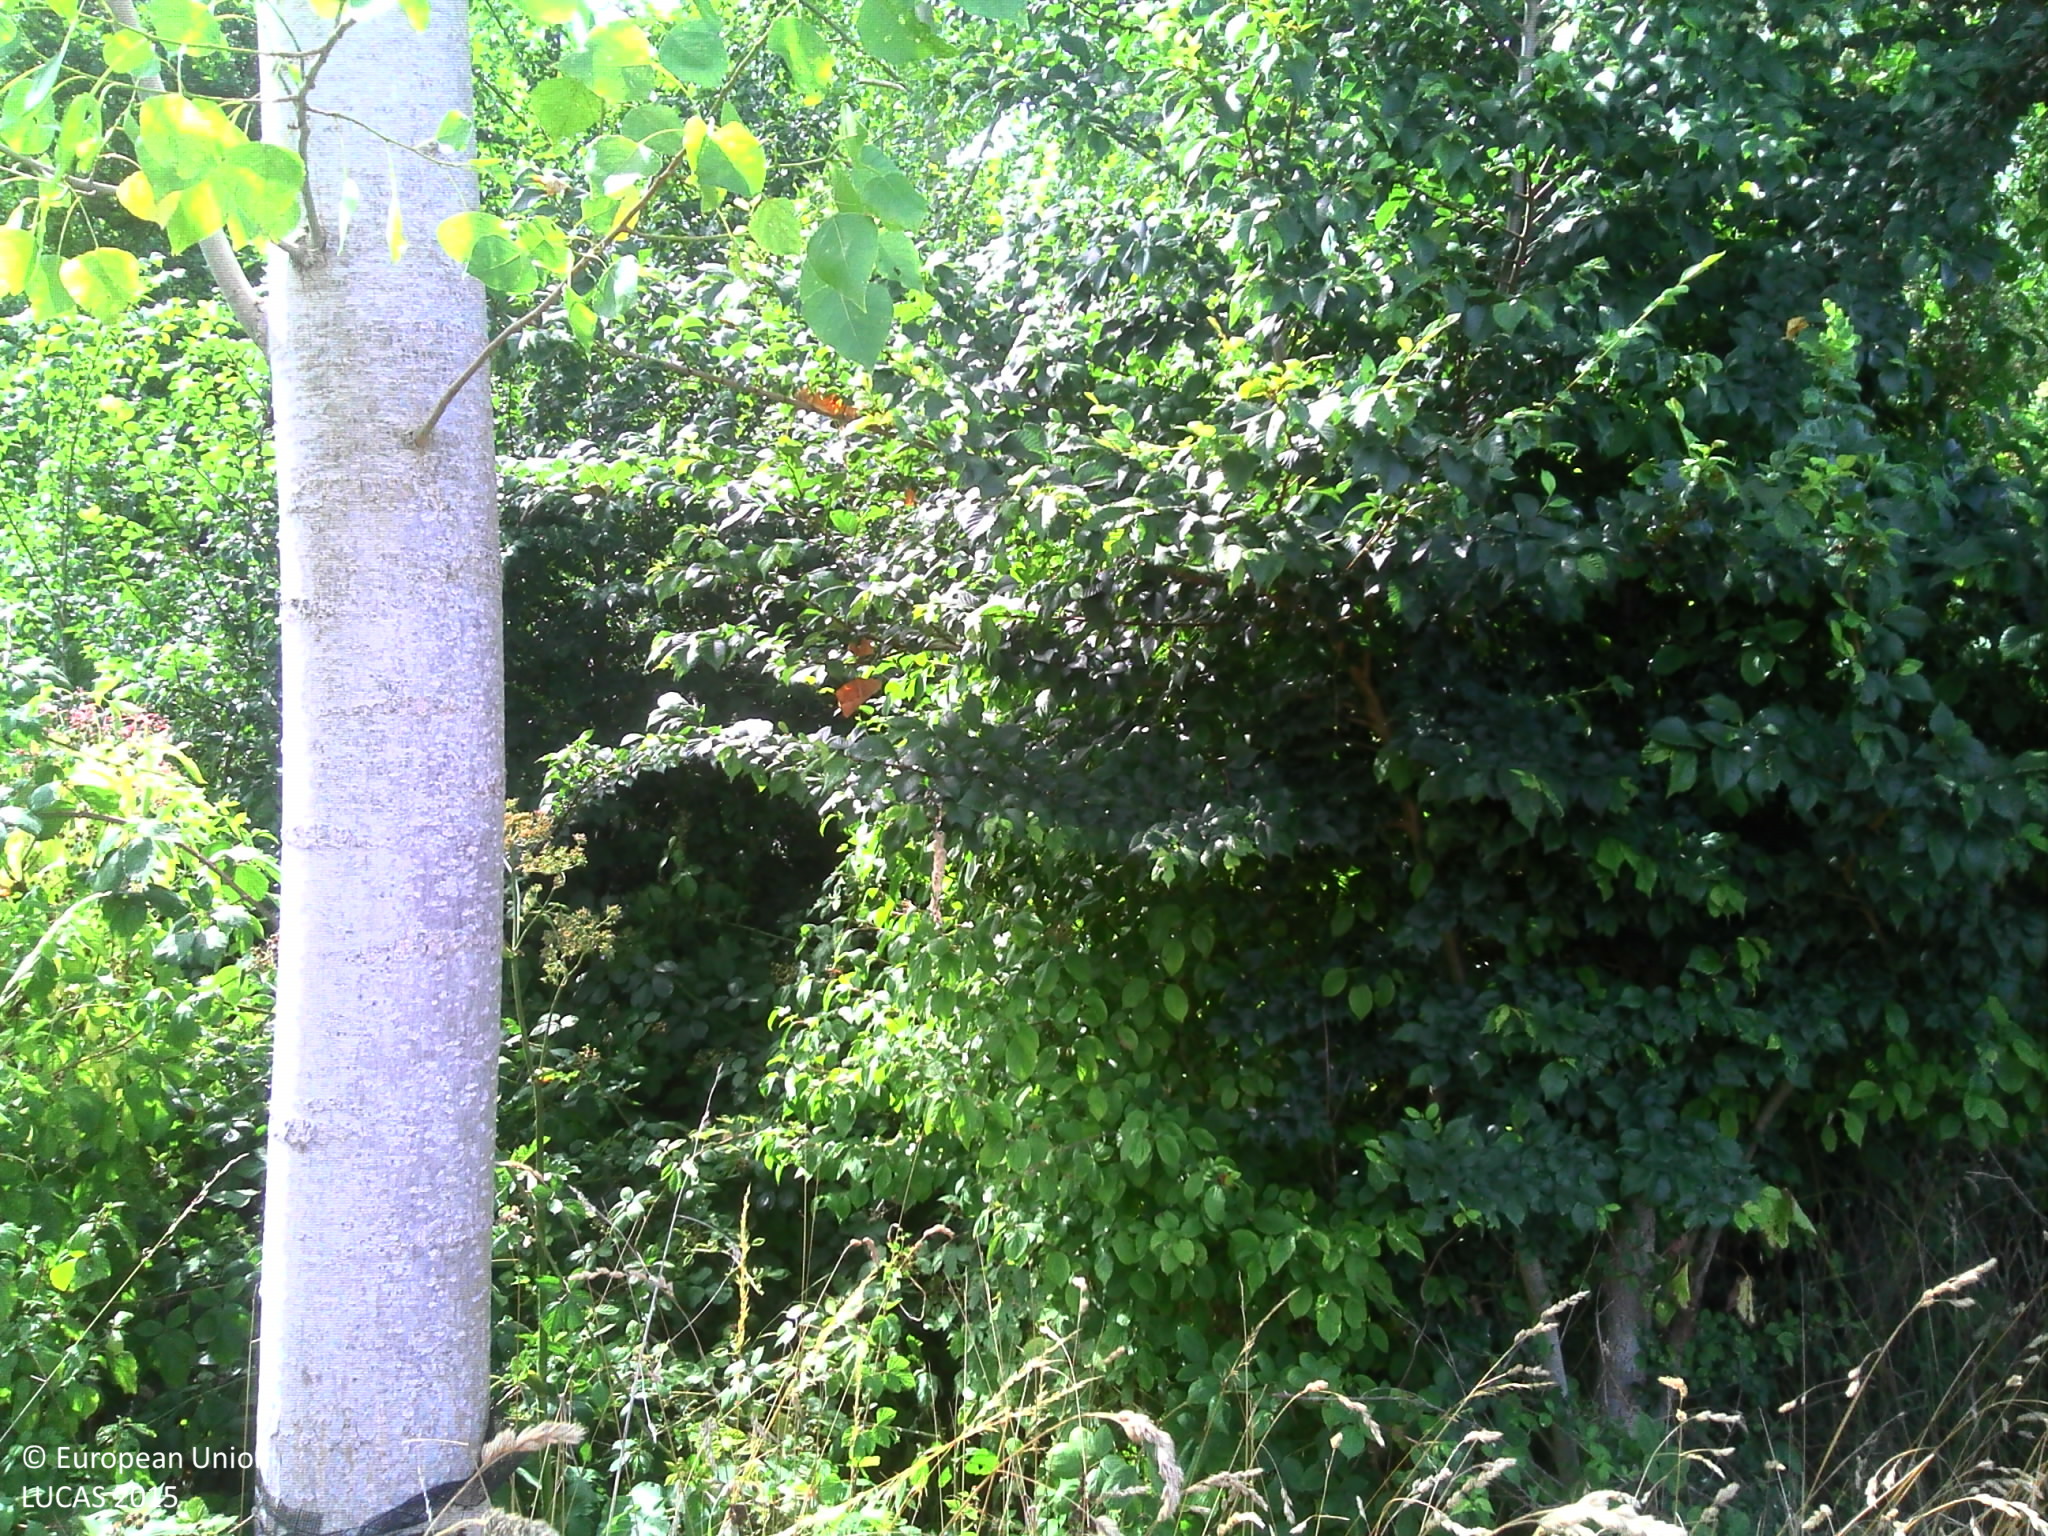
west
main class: Woodland
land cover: Broadleaved woodland
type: exotic forest
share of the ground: > 75 %
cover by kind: broadleaved forest trees 55 %, herbaceous plants 15 %, lichens and mosses 15 %, unconsolidated bare surface 5 %
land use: Forestry
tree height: > 5 m
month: August
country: FR
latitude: 48.6890
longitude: 3.3231
